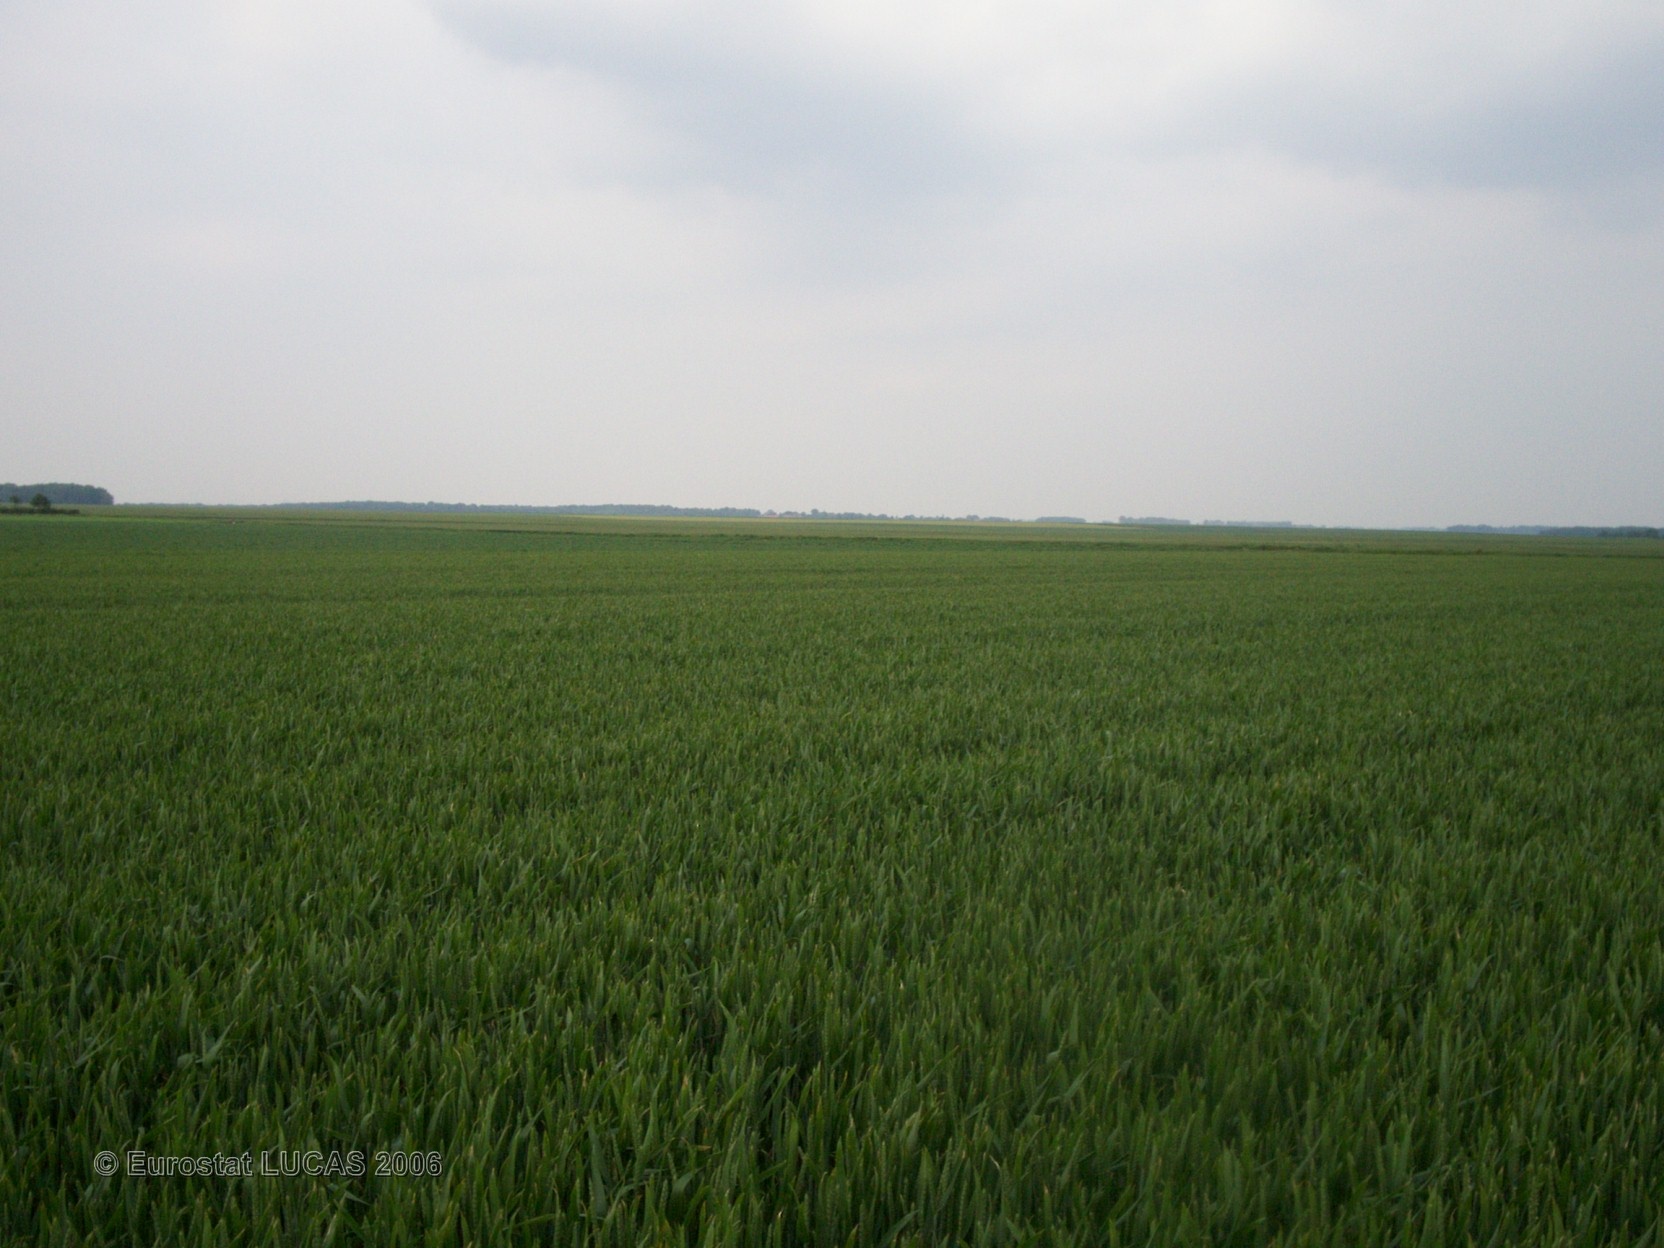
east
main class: Cropland
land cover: Common wheat
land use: Agriculture (excluding fallow land and kitchen gardens)
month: June
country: FR
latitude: 49.6568
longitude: 2.6329
